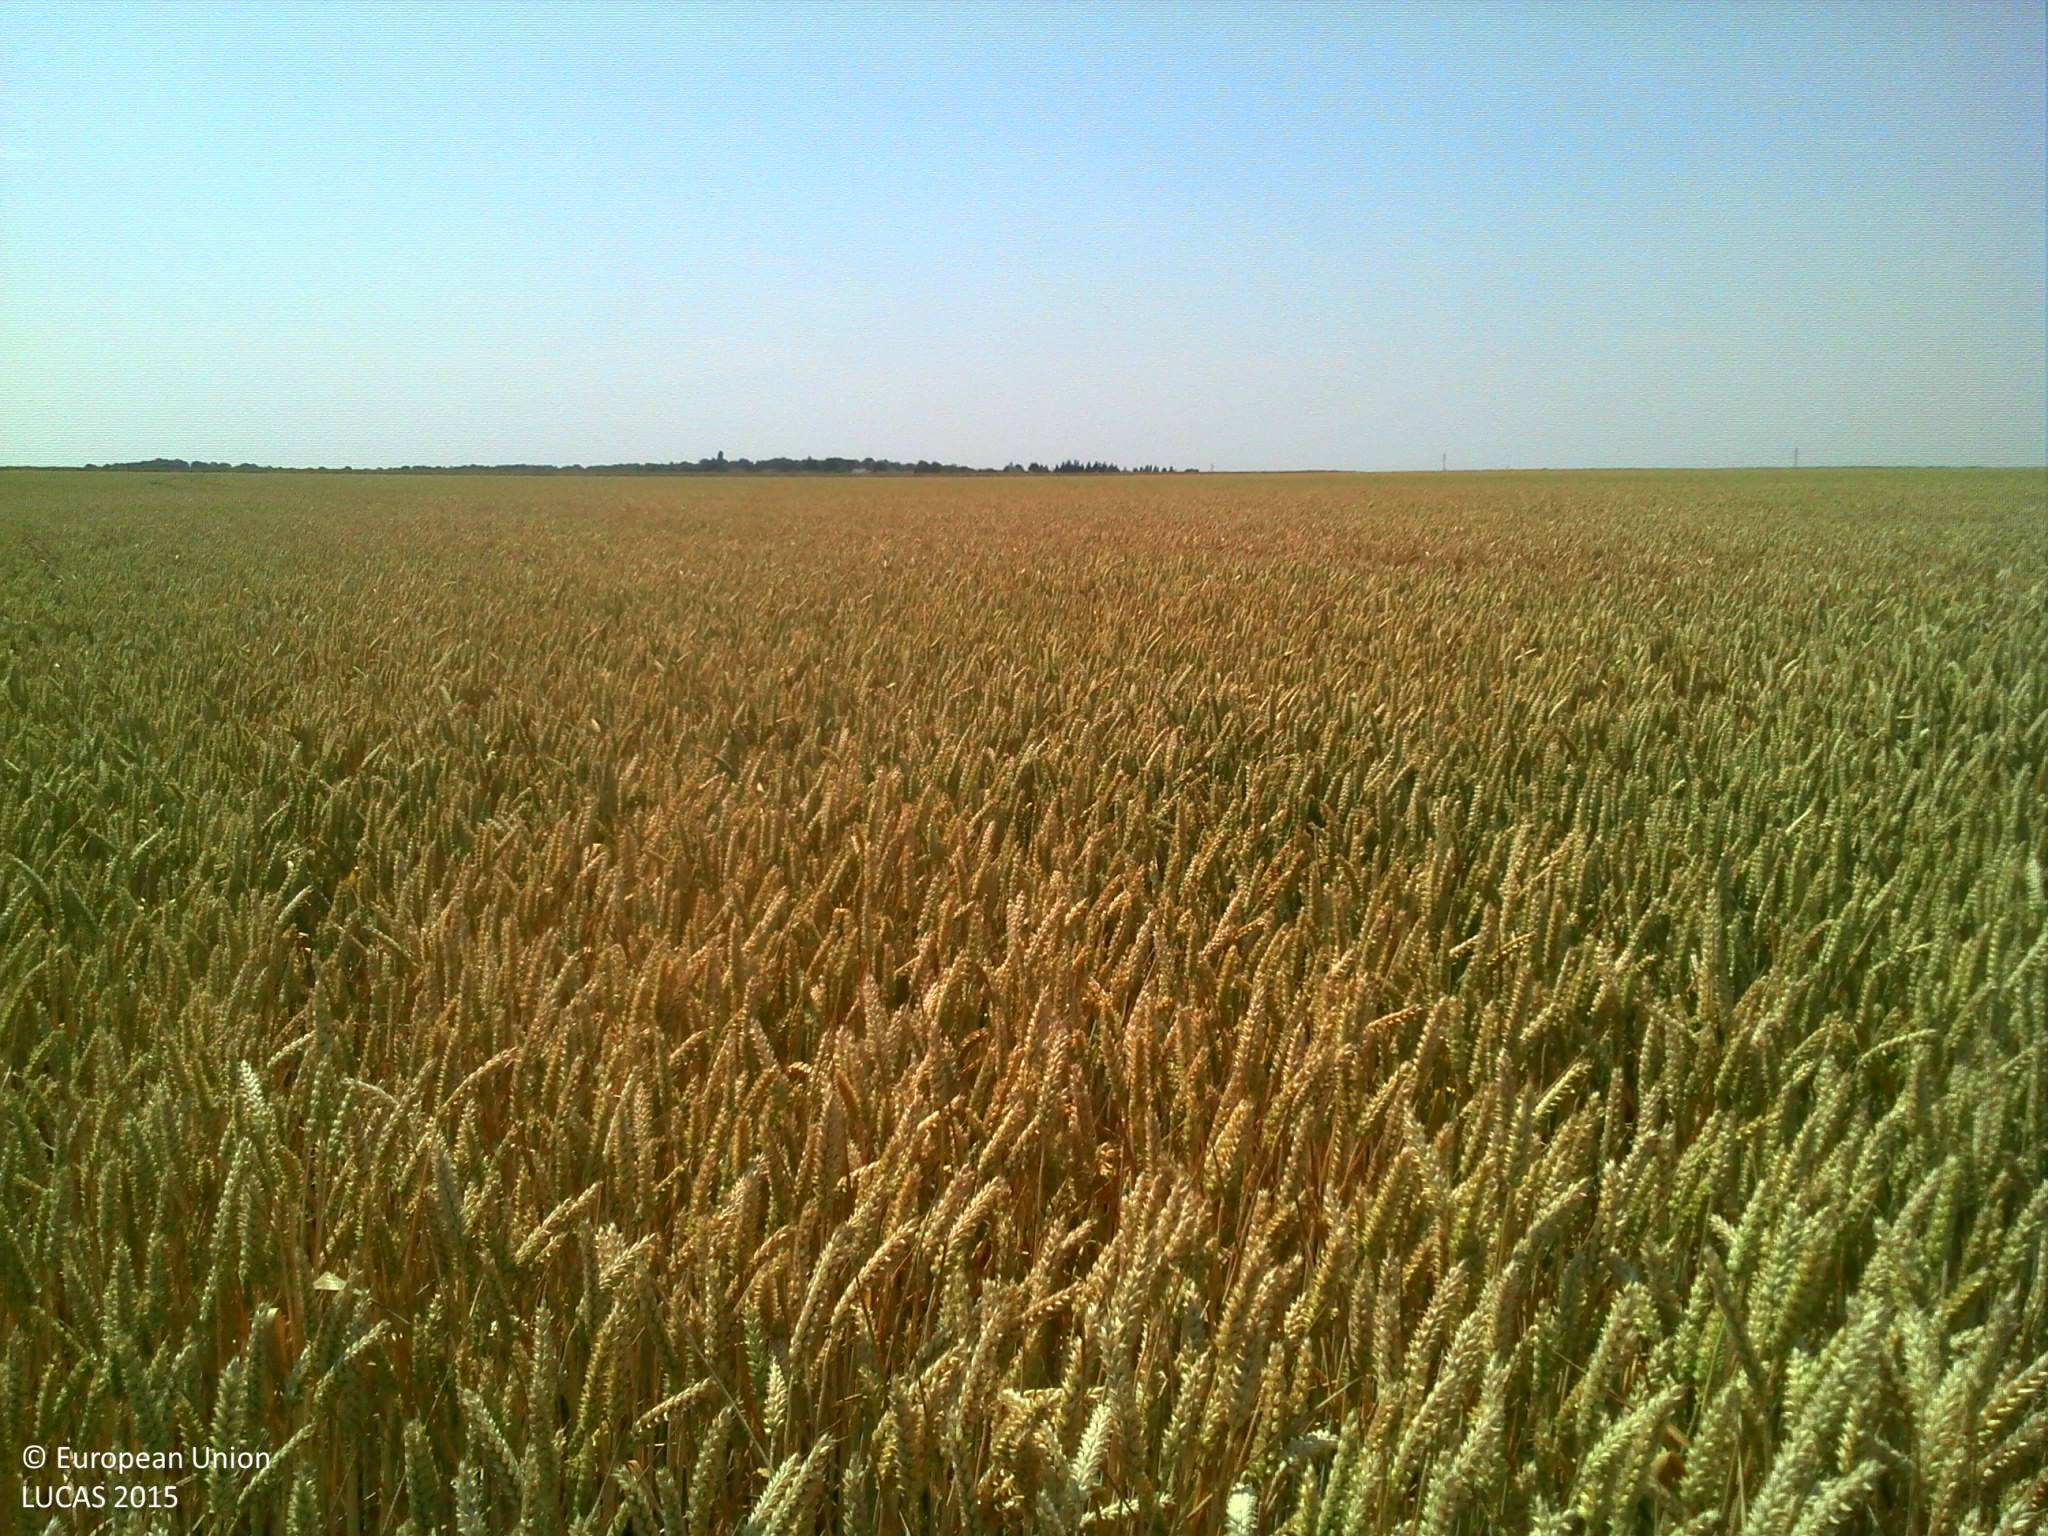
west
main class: Cropland
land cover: Common wheat
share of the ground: > 75 %
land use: Agriculture (excluding fallow land and kitchen gardens)
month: July
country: FR
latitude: 48.9454
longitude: 1.2832
